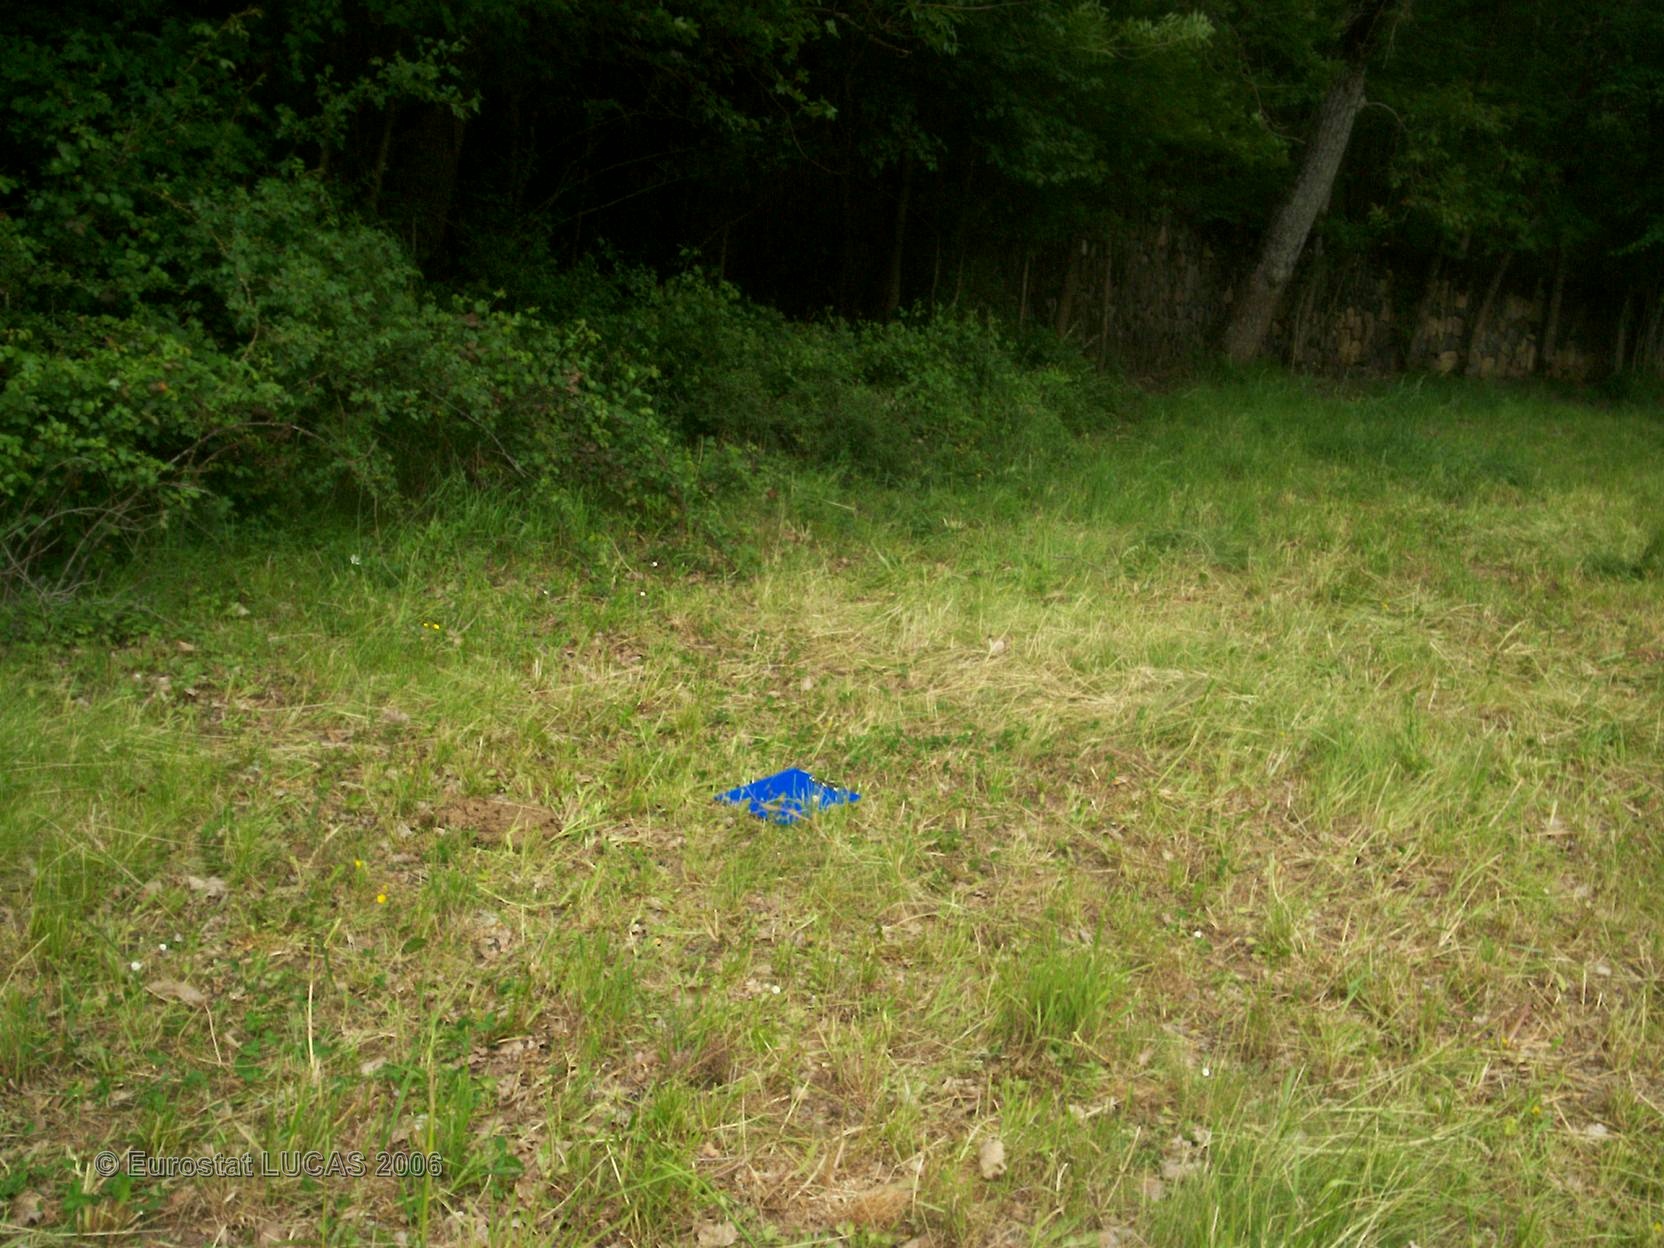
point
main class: Grassland
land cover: Grassland without tree/shrub cover
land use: Agriculture (excluding fallow land and kitchen gardens)
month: June
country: FR
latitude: 44.5202
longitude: 3.3998
